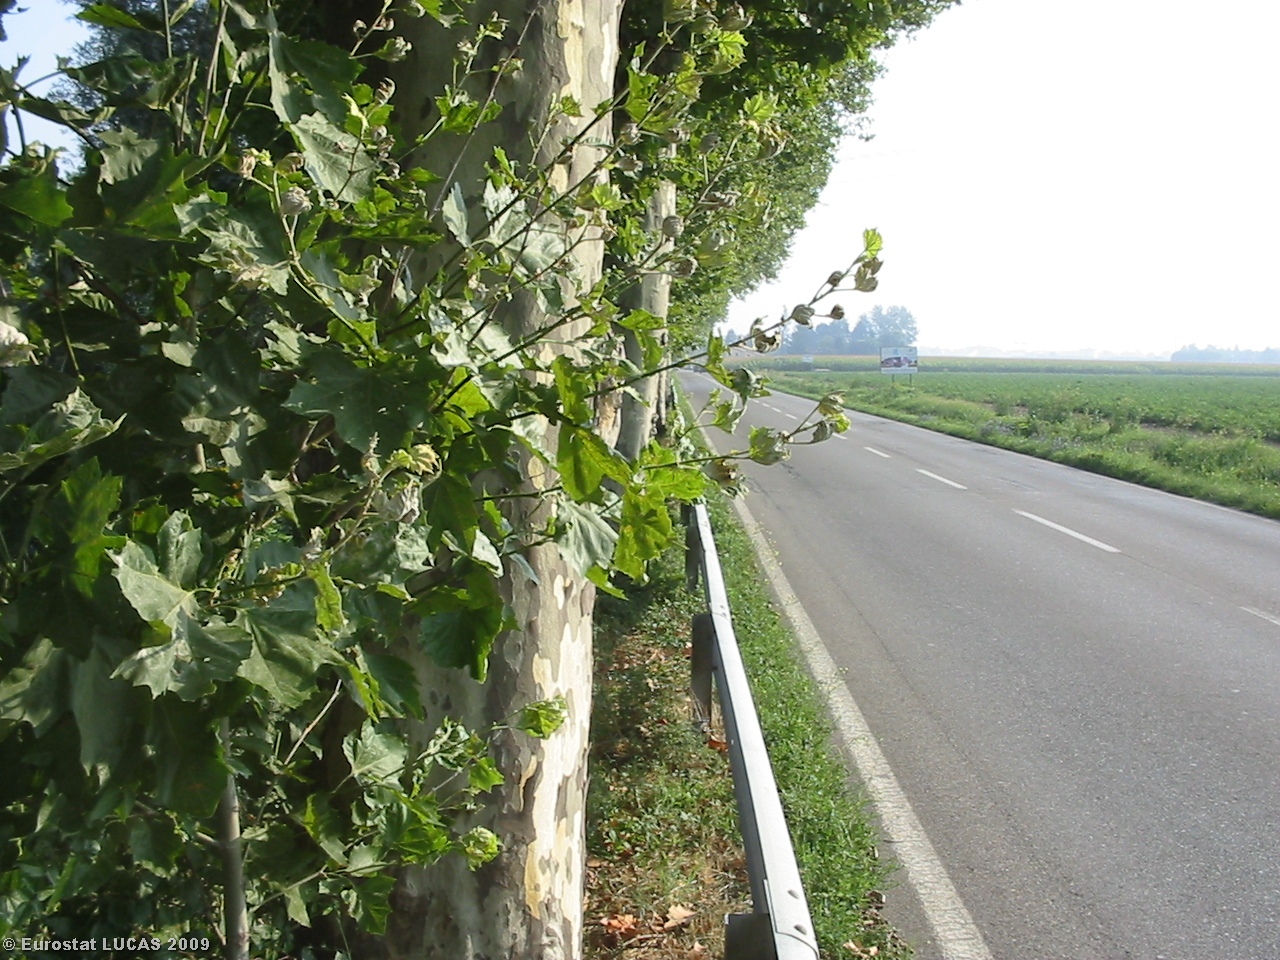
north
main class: Cropland
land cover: Lucerne
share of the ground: > 75 %
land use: Agriculture (excluding fallow land and kitchen gardens)
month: July
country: IT
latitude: 44.7468
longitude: 10.3151
